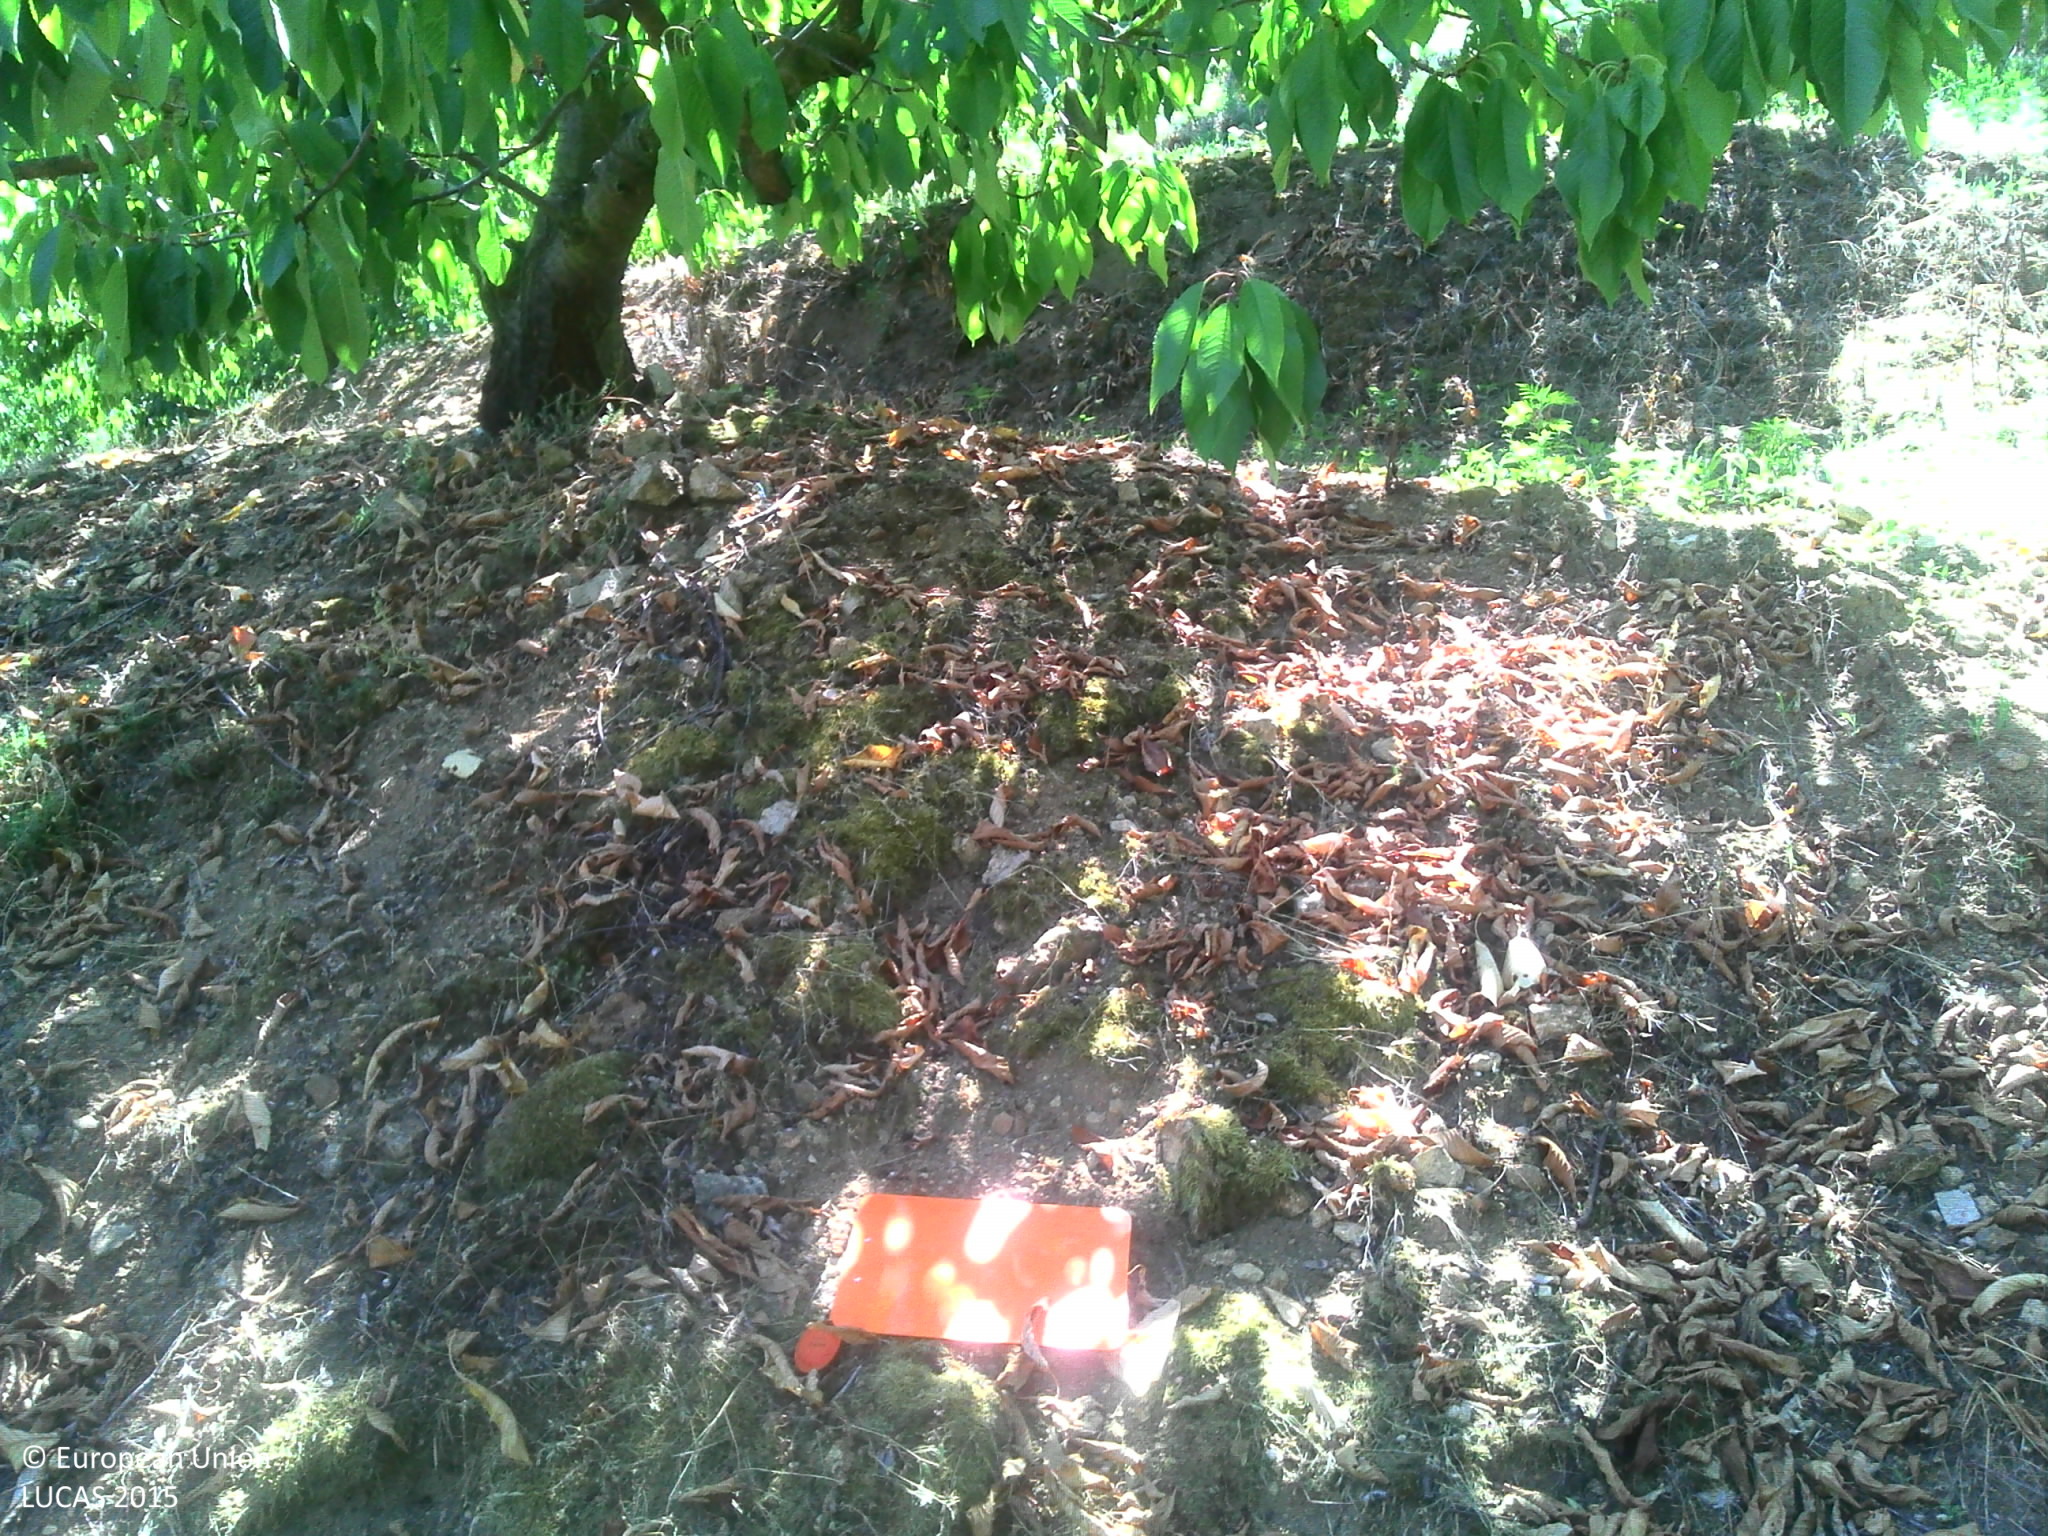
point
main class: Cropland
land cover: Cherry fruit
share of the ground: 50 - 75 %
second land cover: Other bare soil
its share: > 75 %
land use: Agriculture (excluding fallow land and kitchen gardens)
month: July
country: FR
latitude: 45.0249
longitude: 4.6368
